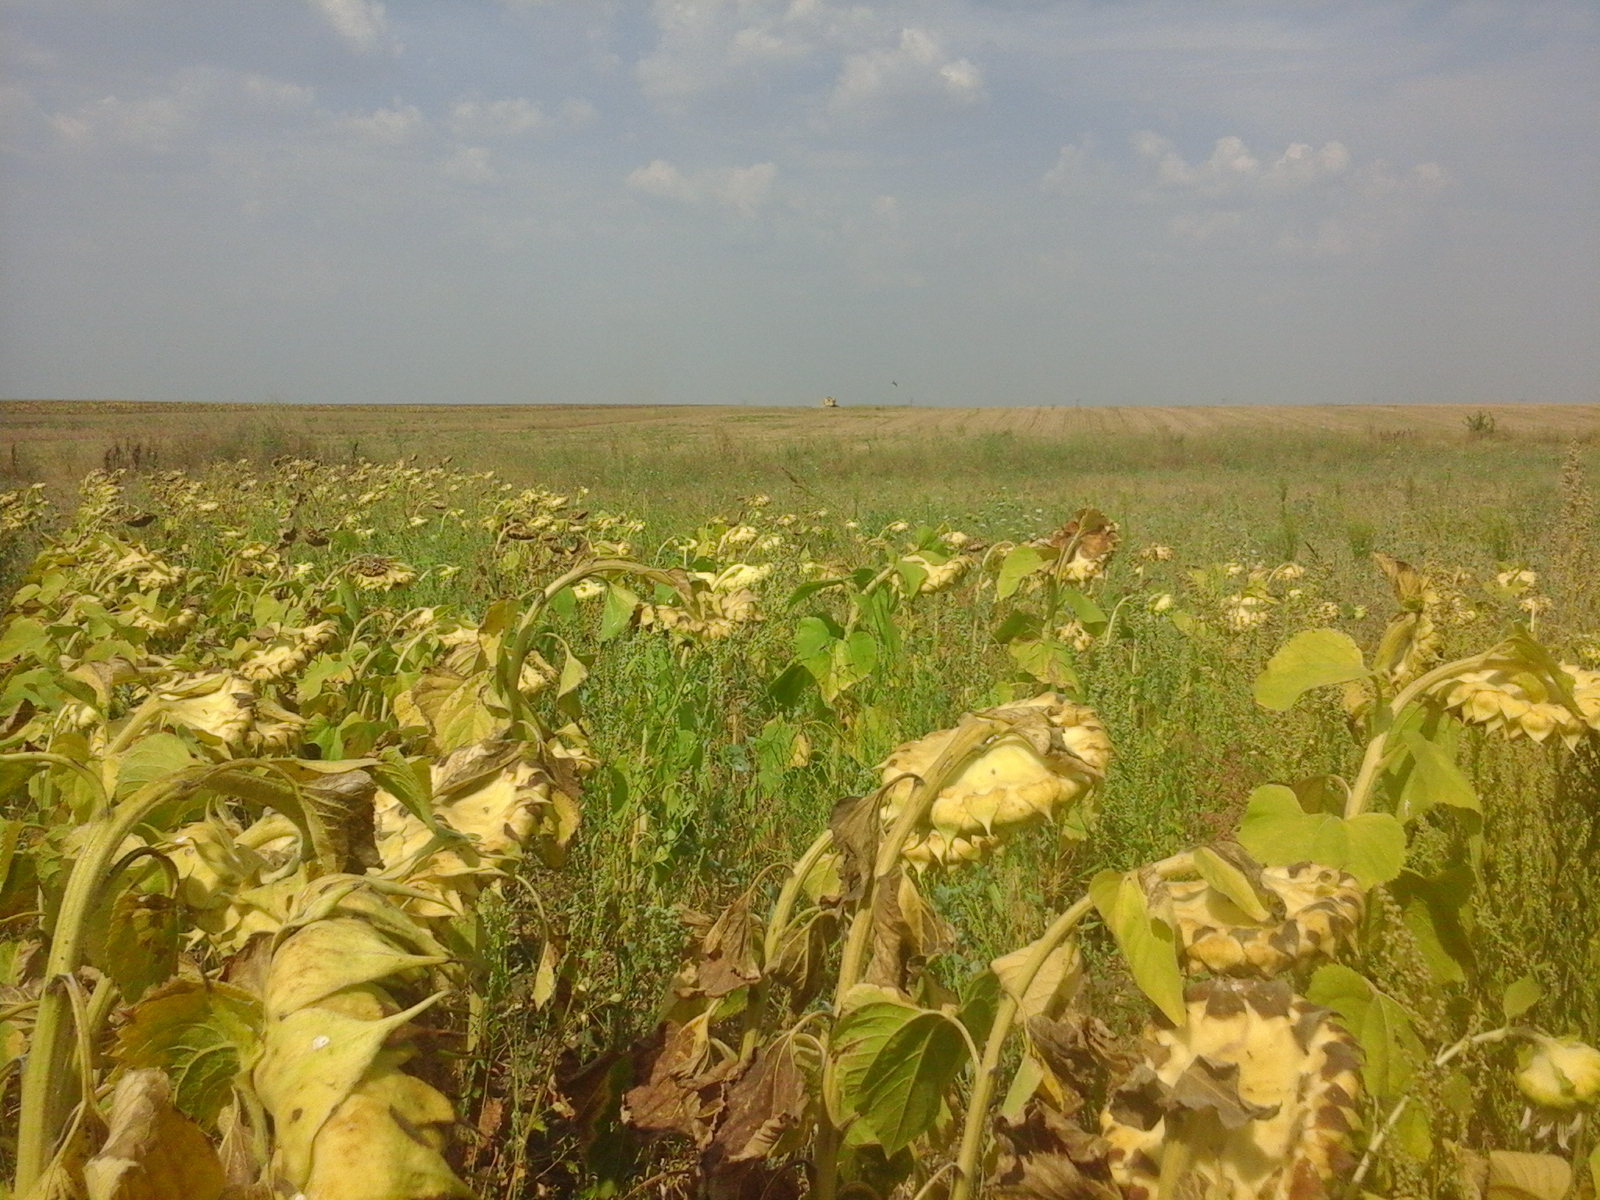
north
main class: Cropland
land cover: Sunflower
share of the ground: > 75 %
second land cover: Spontaneously vegetated surfaces
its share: 50 - 75 %
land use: Agriculture (excluding fallow land and kitchen gardens)
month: August
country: RO
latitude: 44.0718
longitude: 23.5985
